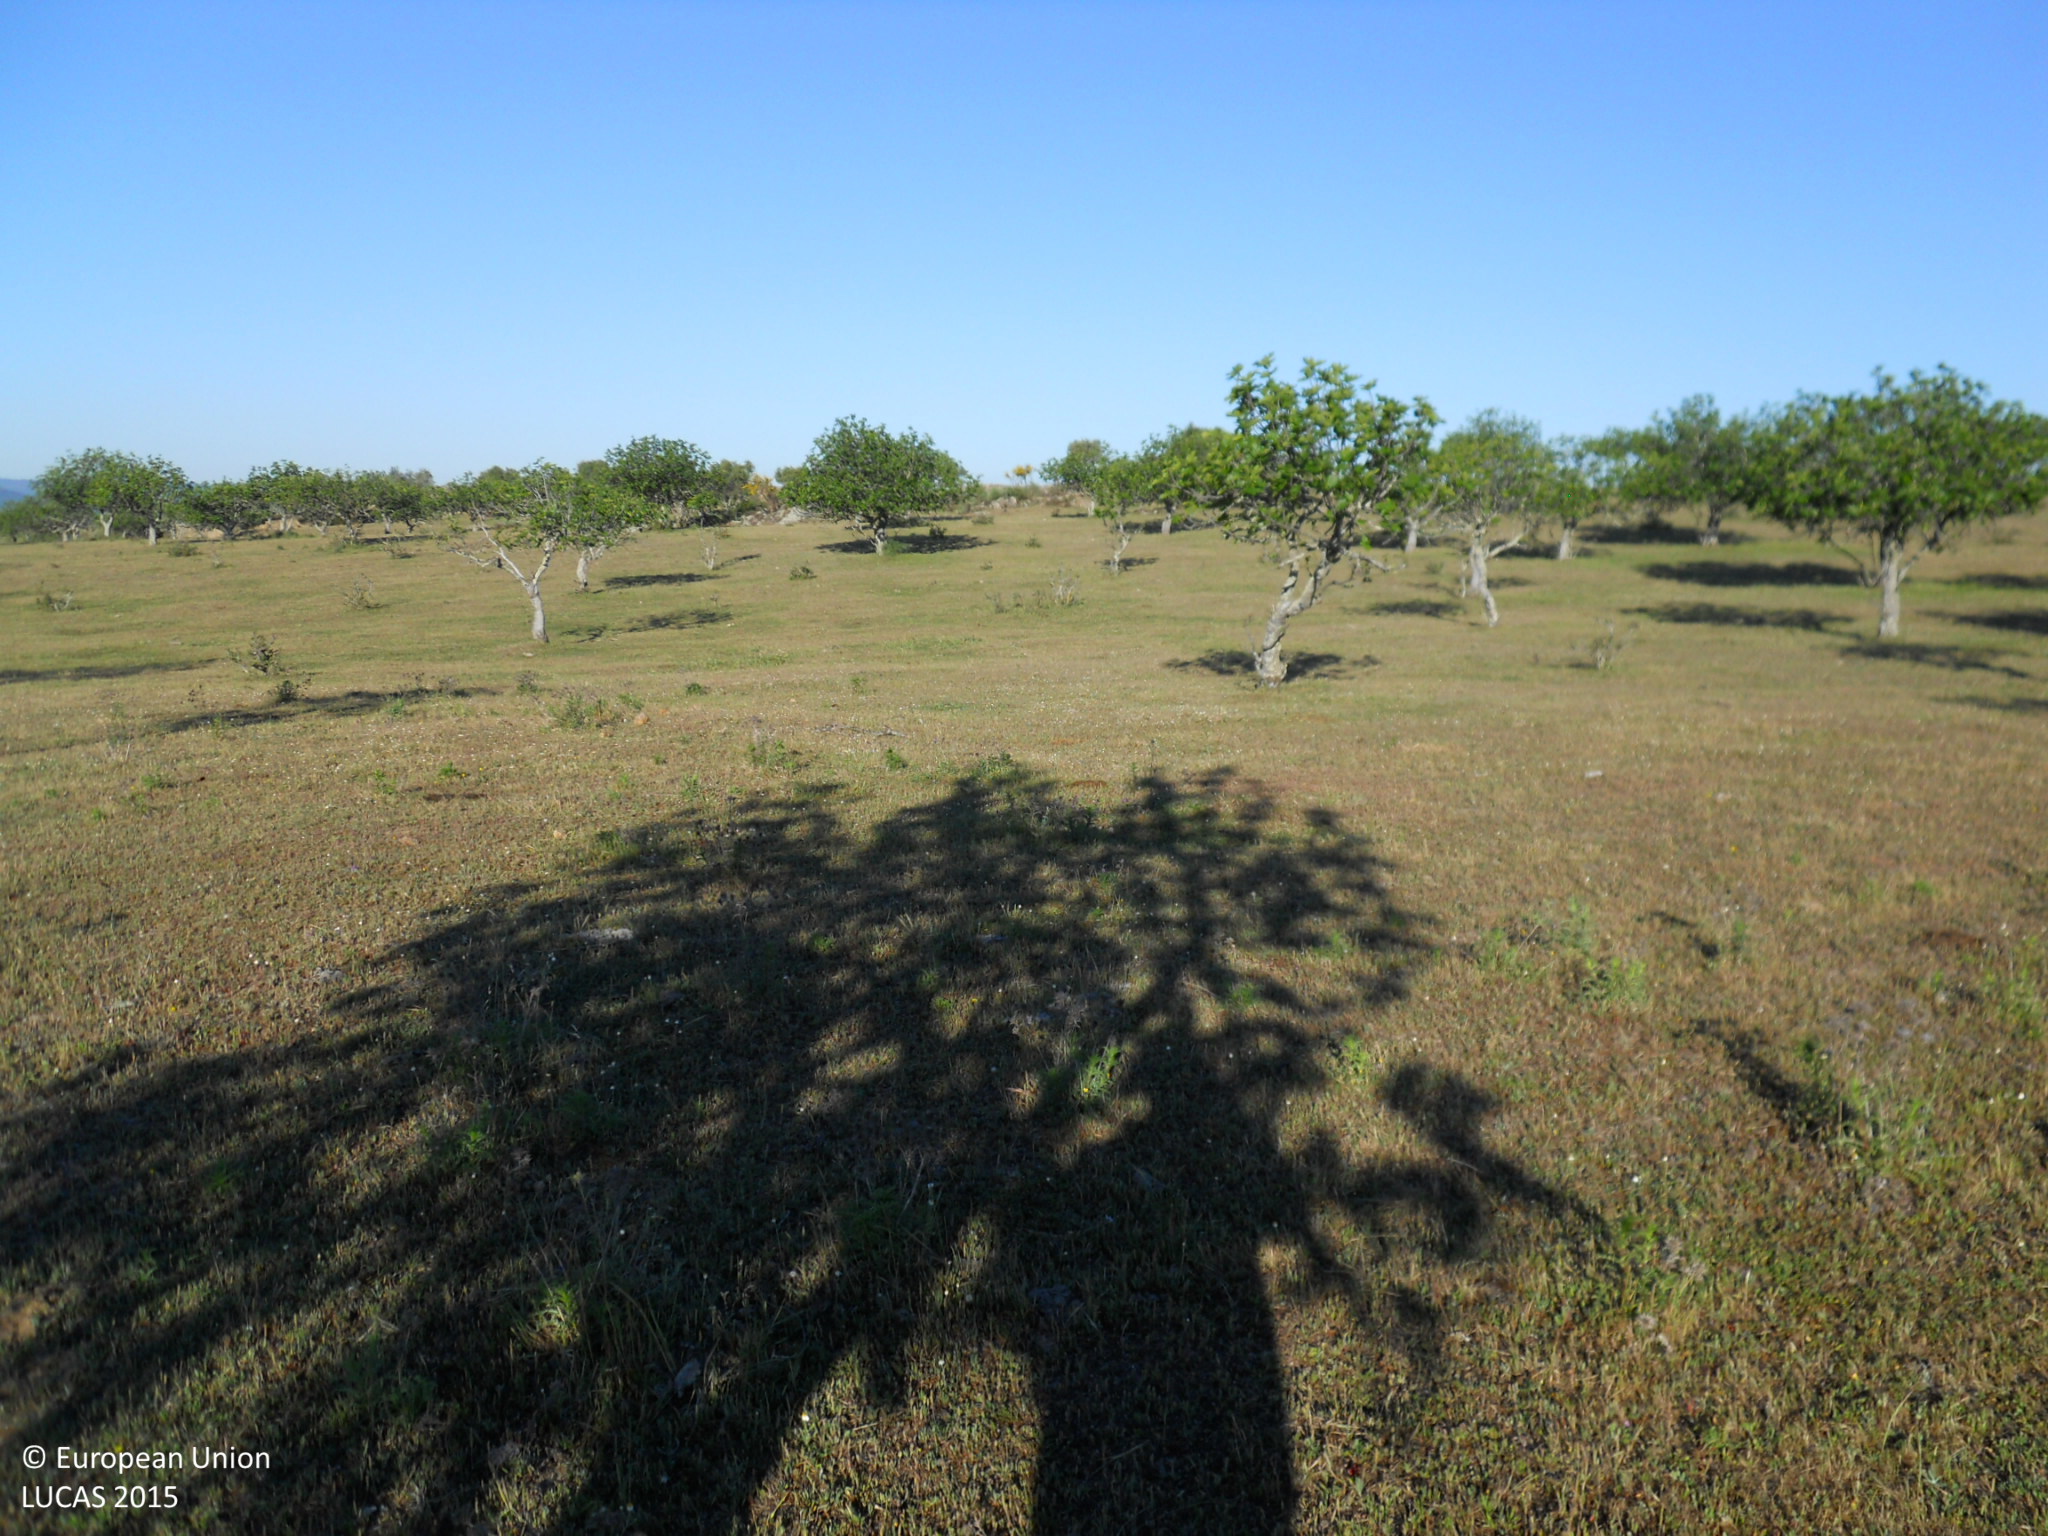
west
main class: Cropland
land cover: Other fruit trees and berries
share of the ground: 25 - 50 %
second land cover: Spontaneously vegetated surfaces
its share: > 75 %
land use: Agriculture (excluding fallow land and kitchen gardens)
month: April
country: ES
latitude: 39.2849
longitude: -7.0161
